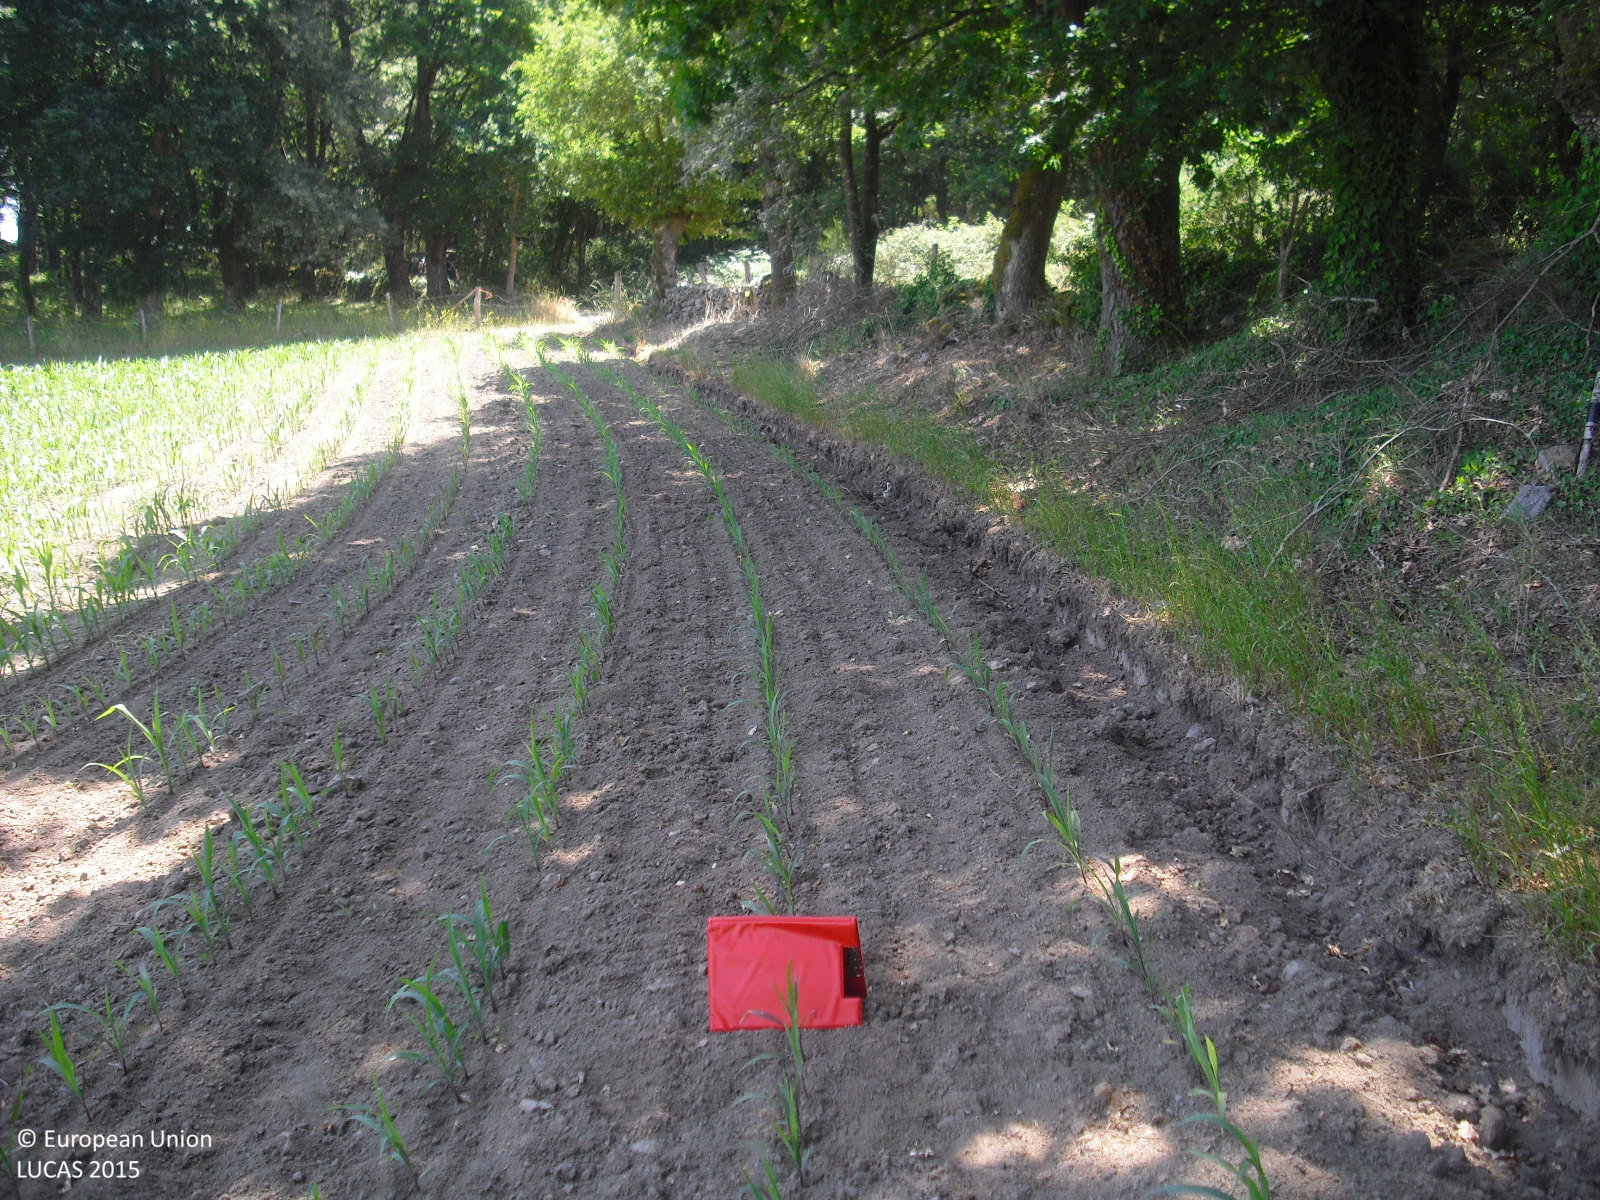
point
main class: Cropland
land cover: Maize
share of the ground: 25 - 50 %
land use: Agriculture (excluding fallow land and kitchen gardens)
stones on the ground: < 10 %
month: June
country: ES
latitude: 42.6526
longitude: -7.7785
